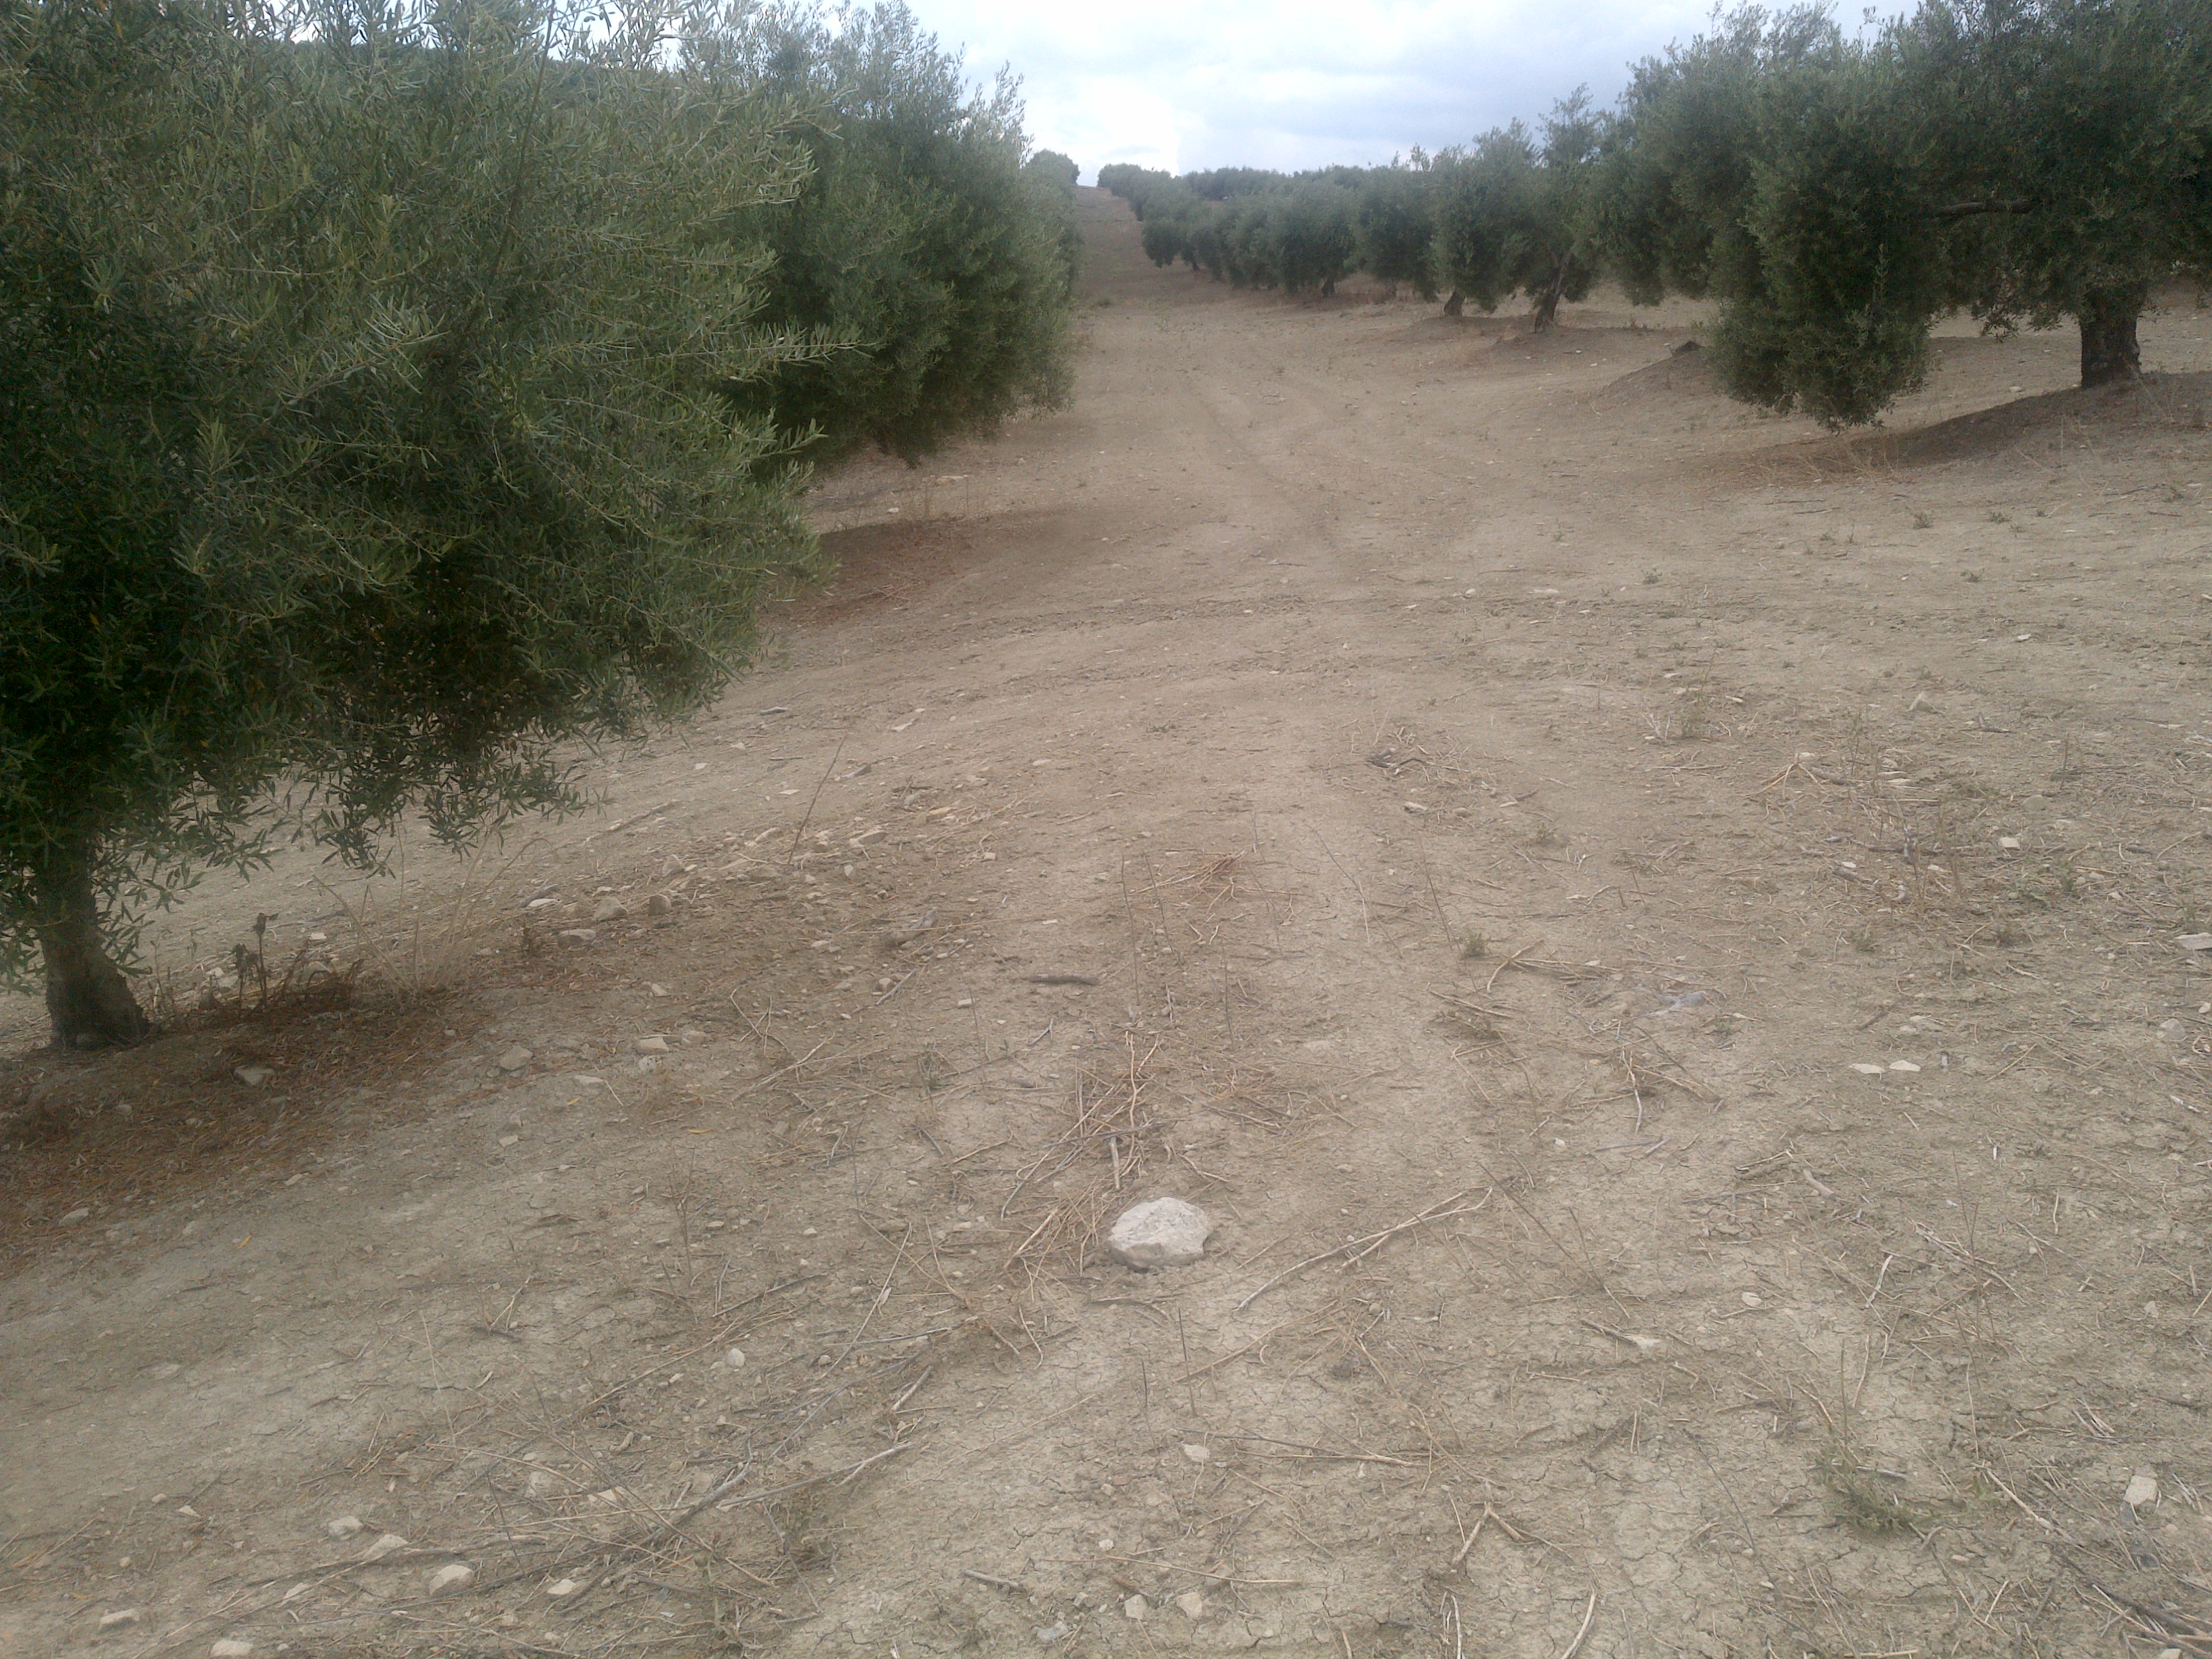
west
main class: Cropland
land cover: Olive groves
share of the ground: 25 - 50 %
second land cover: Other bare soil
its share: > 75 %
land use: Agriculture (excluding fallow land and kitchen gardens)
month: June
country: ES
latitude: 37.8028
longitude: -4.2832
